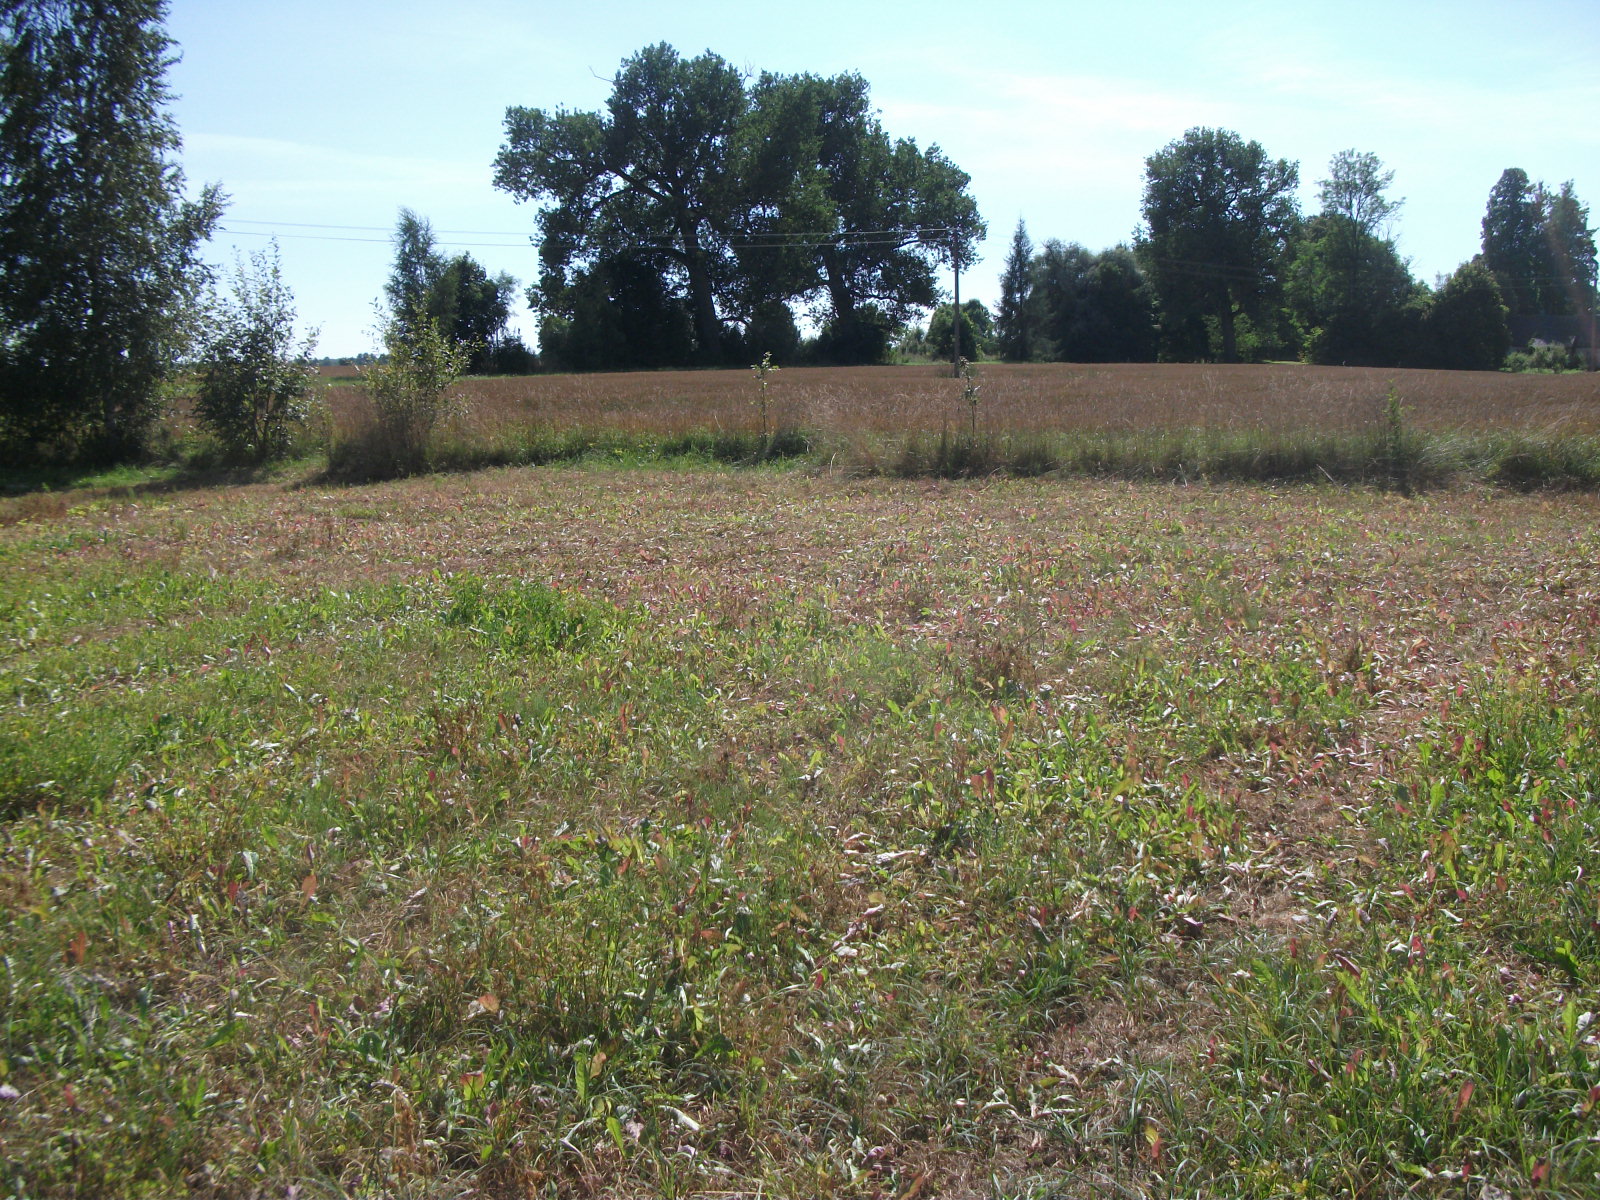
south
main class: Grassland
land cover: Grassland without tree/shrub cover
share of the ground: > 75 %
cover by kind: herbaceous plants 100 %
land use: Agriculture (excluding fallow land and kitchen gardens)
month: August
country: LV
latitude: 56.1828
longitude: 26.3029
